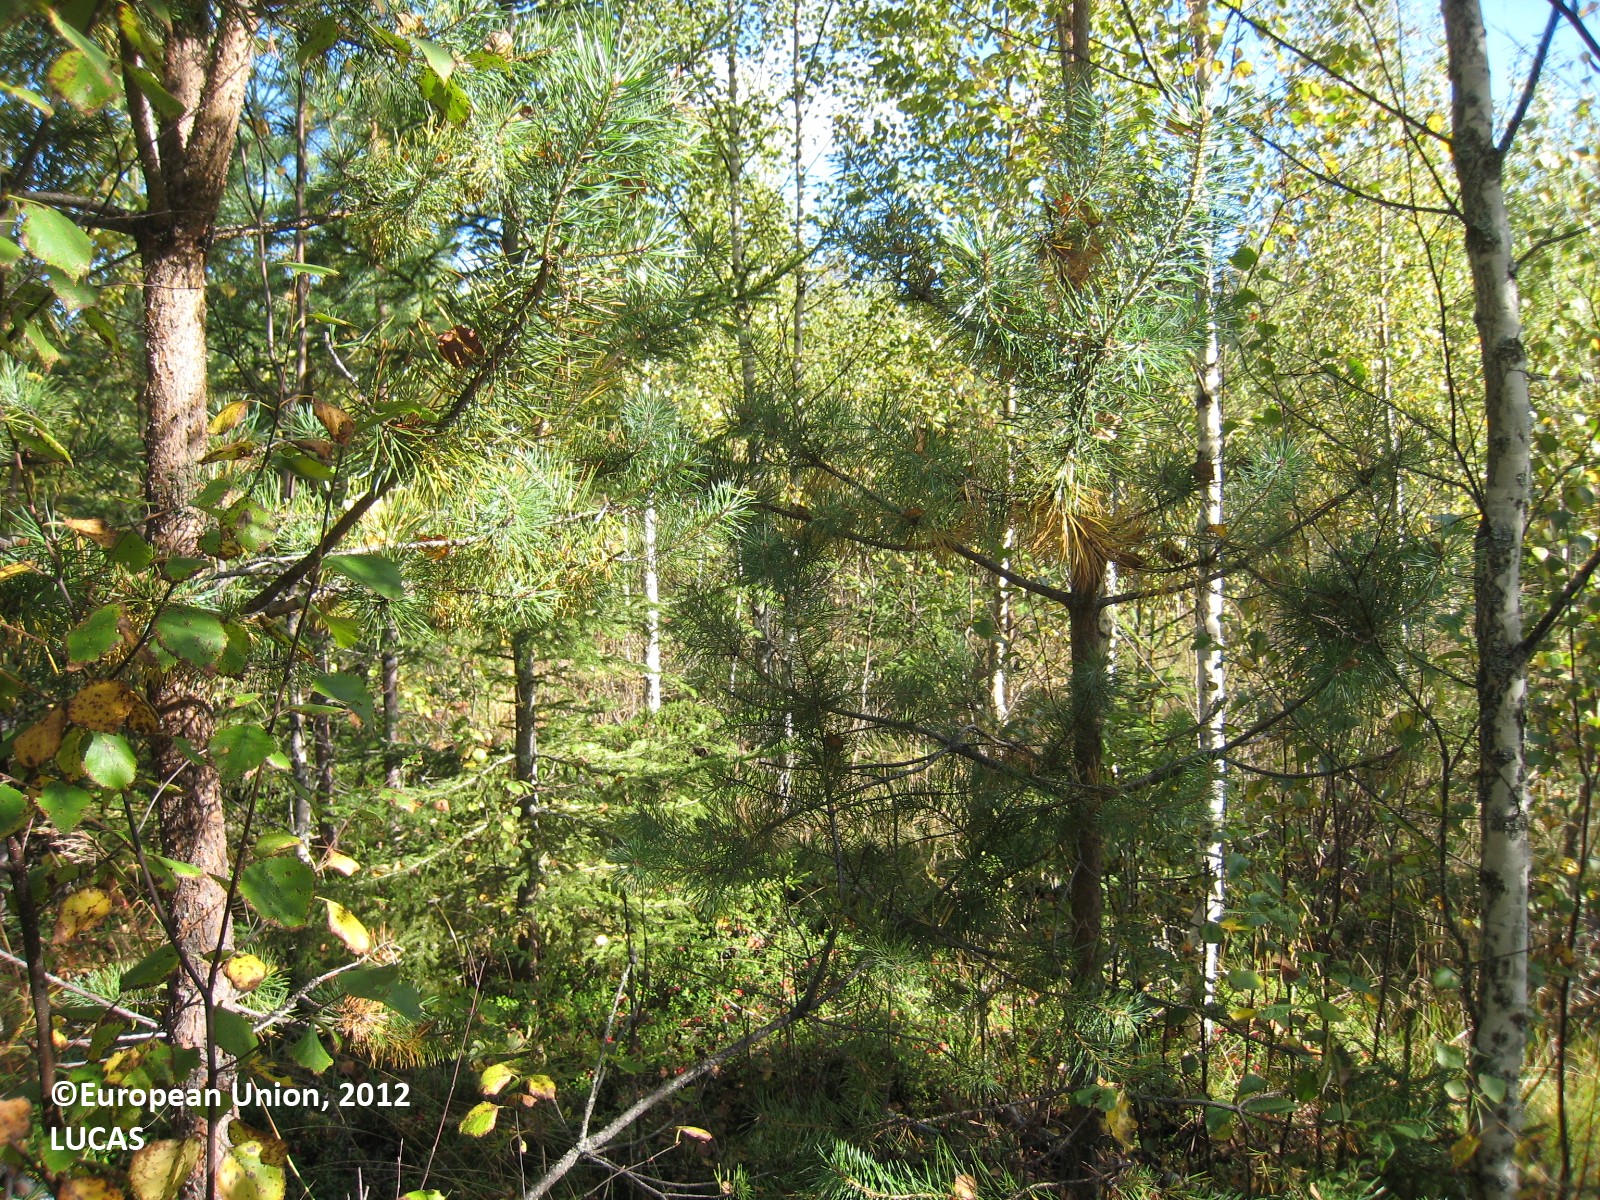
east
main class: Woodland
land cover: Other mixed woodland
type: boreal forest
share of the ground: > 75 %
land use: Forestry
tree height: > 5 m
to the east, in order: Other mixed woodland; Ditches and canals; Other mixed woodland; Pine dominated coniferous woodland; Broadleaved woodland; Pine dominated mixed woodland; Other mixed woodland; Ditches and canals; Shruby margins; Paved roads, cycling and walking lanes; Other bare soil; Ditches and canals; Lichens and moss; Pine dominated mixed woodland
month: September
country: FI
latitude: 63.0068
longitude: 26.8287
